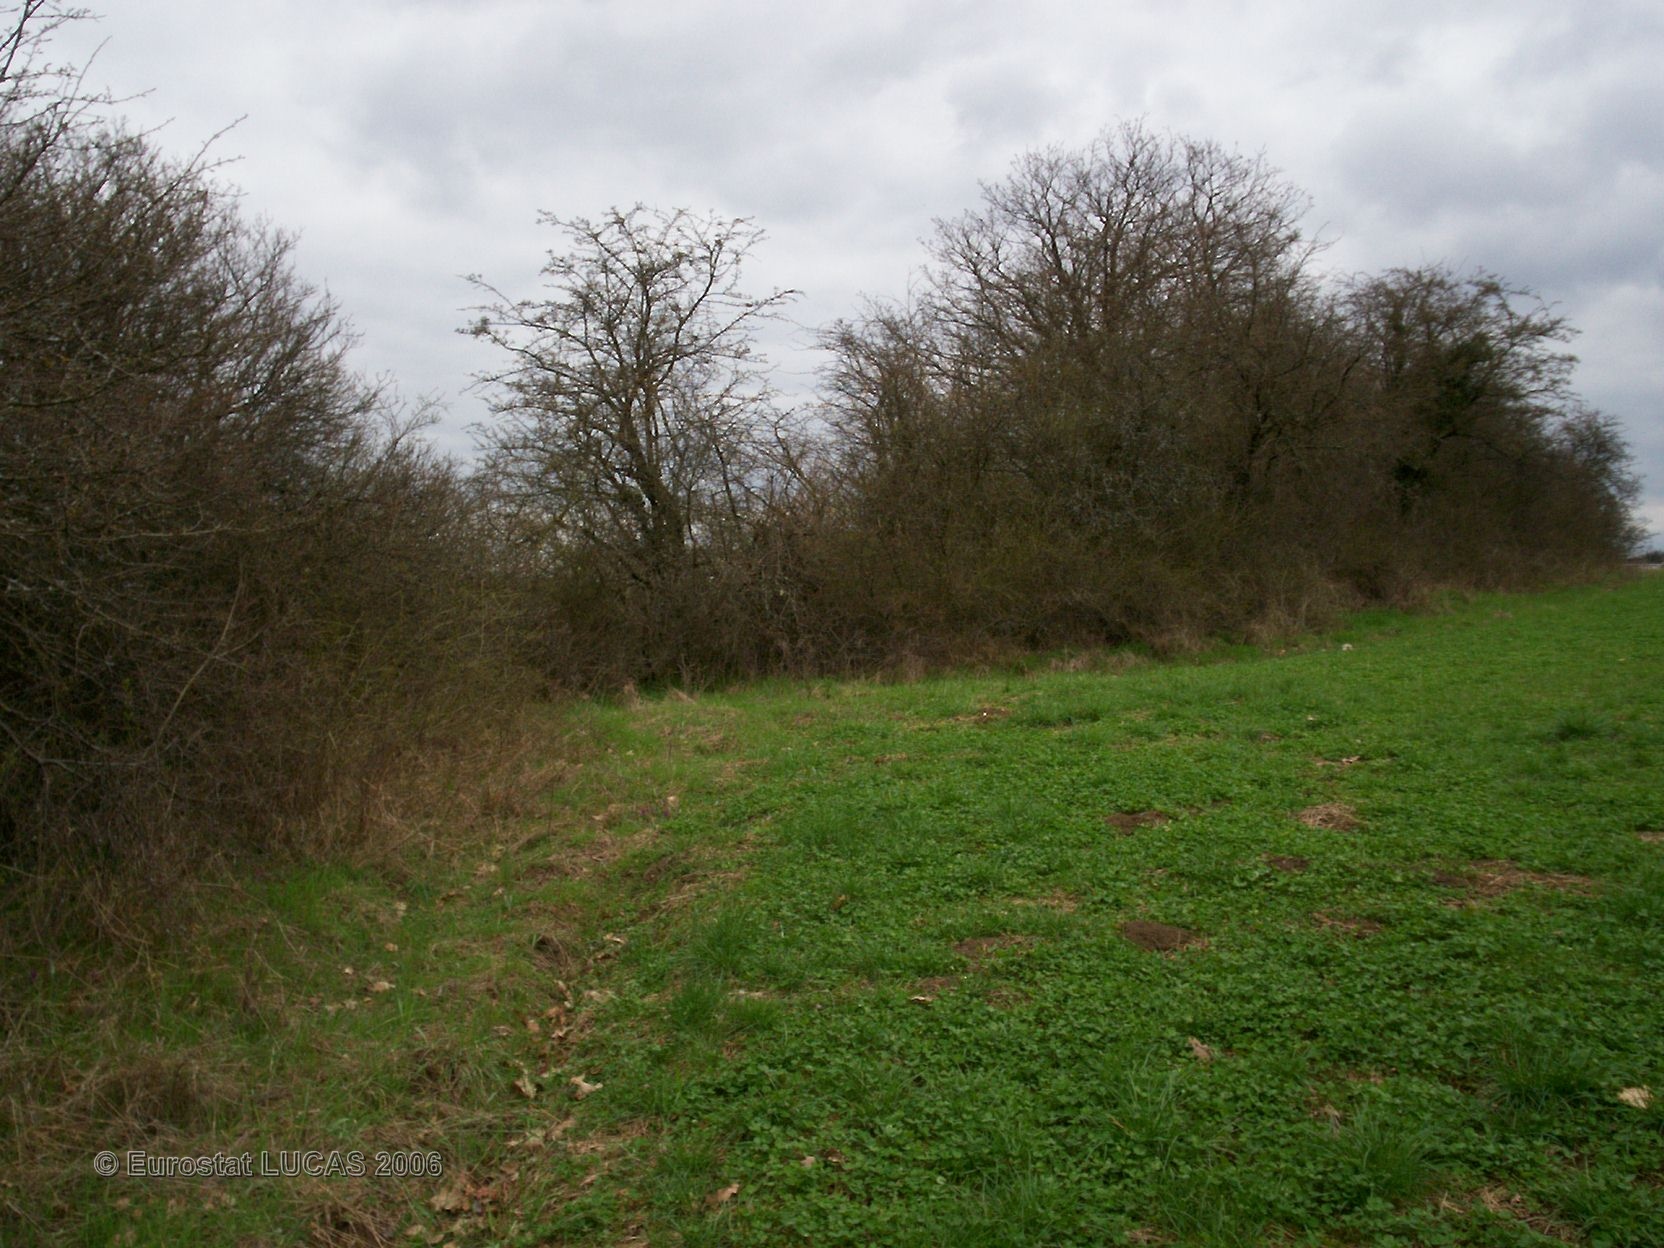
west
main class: Cropland
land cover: Clovers
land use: Agriculture (excluding fallow land and kitchen gardens)
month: April
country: FR
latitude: 47.5287
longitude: 6.8006
